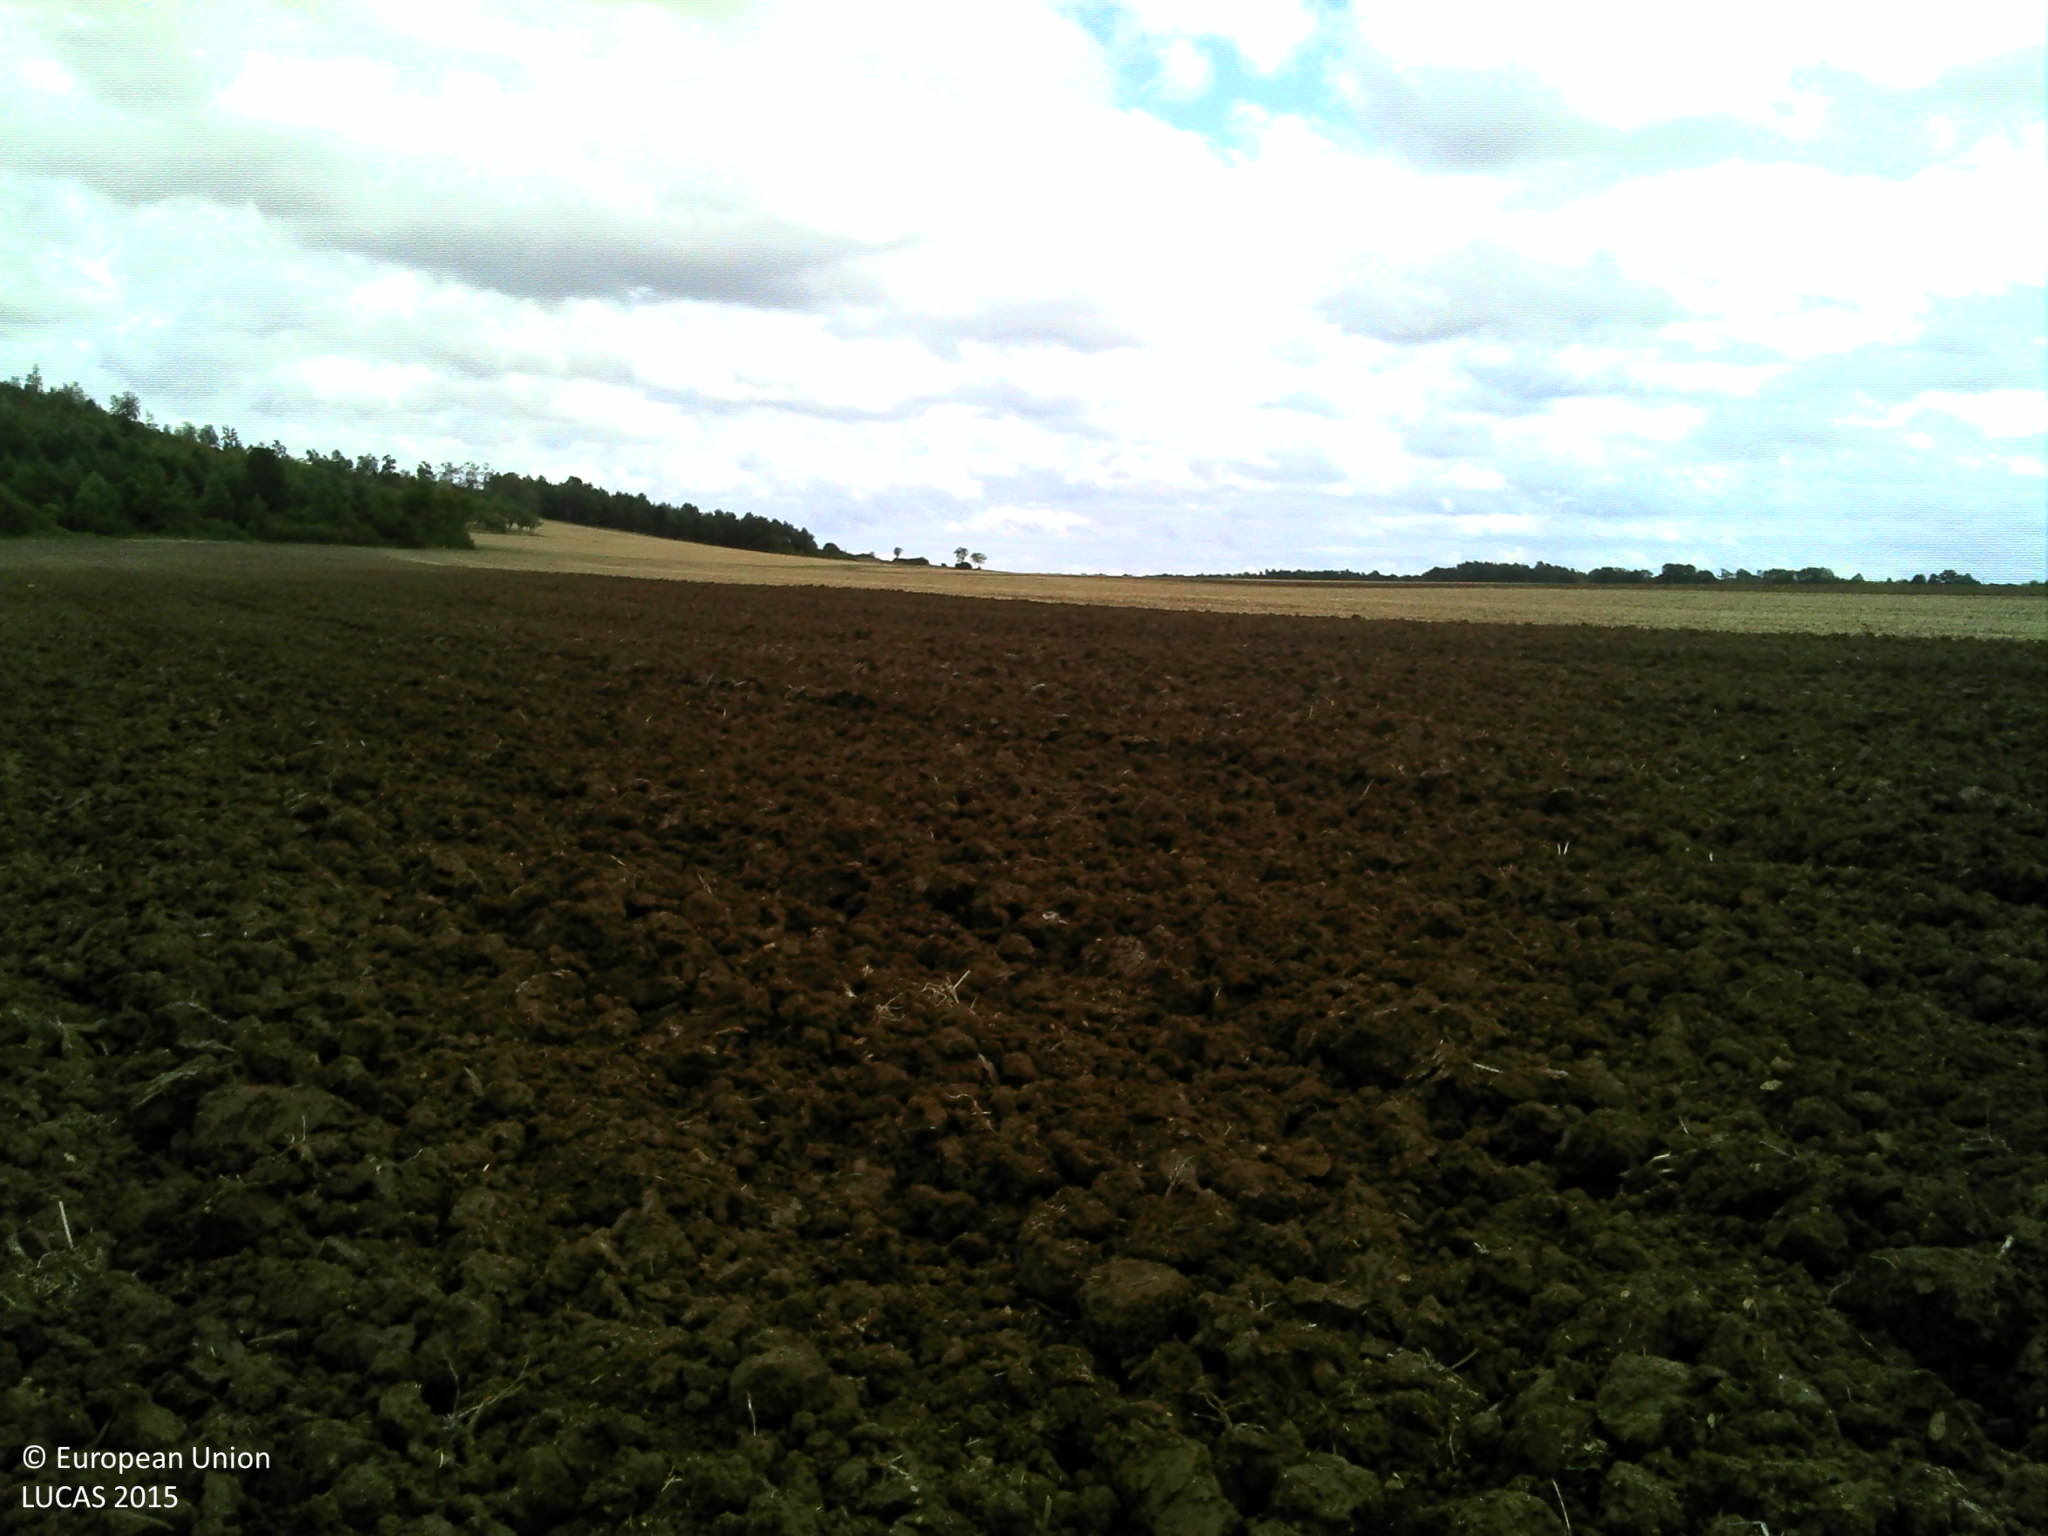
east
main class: Cropland
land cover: Rape and turnip rape
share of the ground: < 10 %
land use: Agriculture (excluding fallow land and kitchen gardens)
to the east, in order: Rape and turnip rape; Common wheat
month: August
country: FR
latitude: 47.9574
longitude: 4.8163
